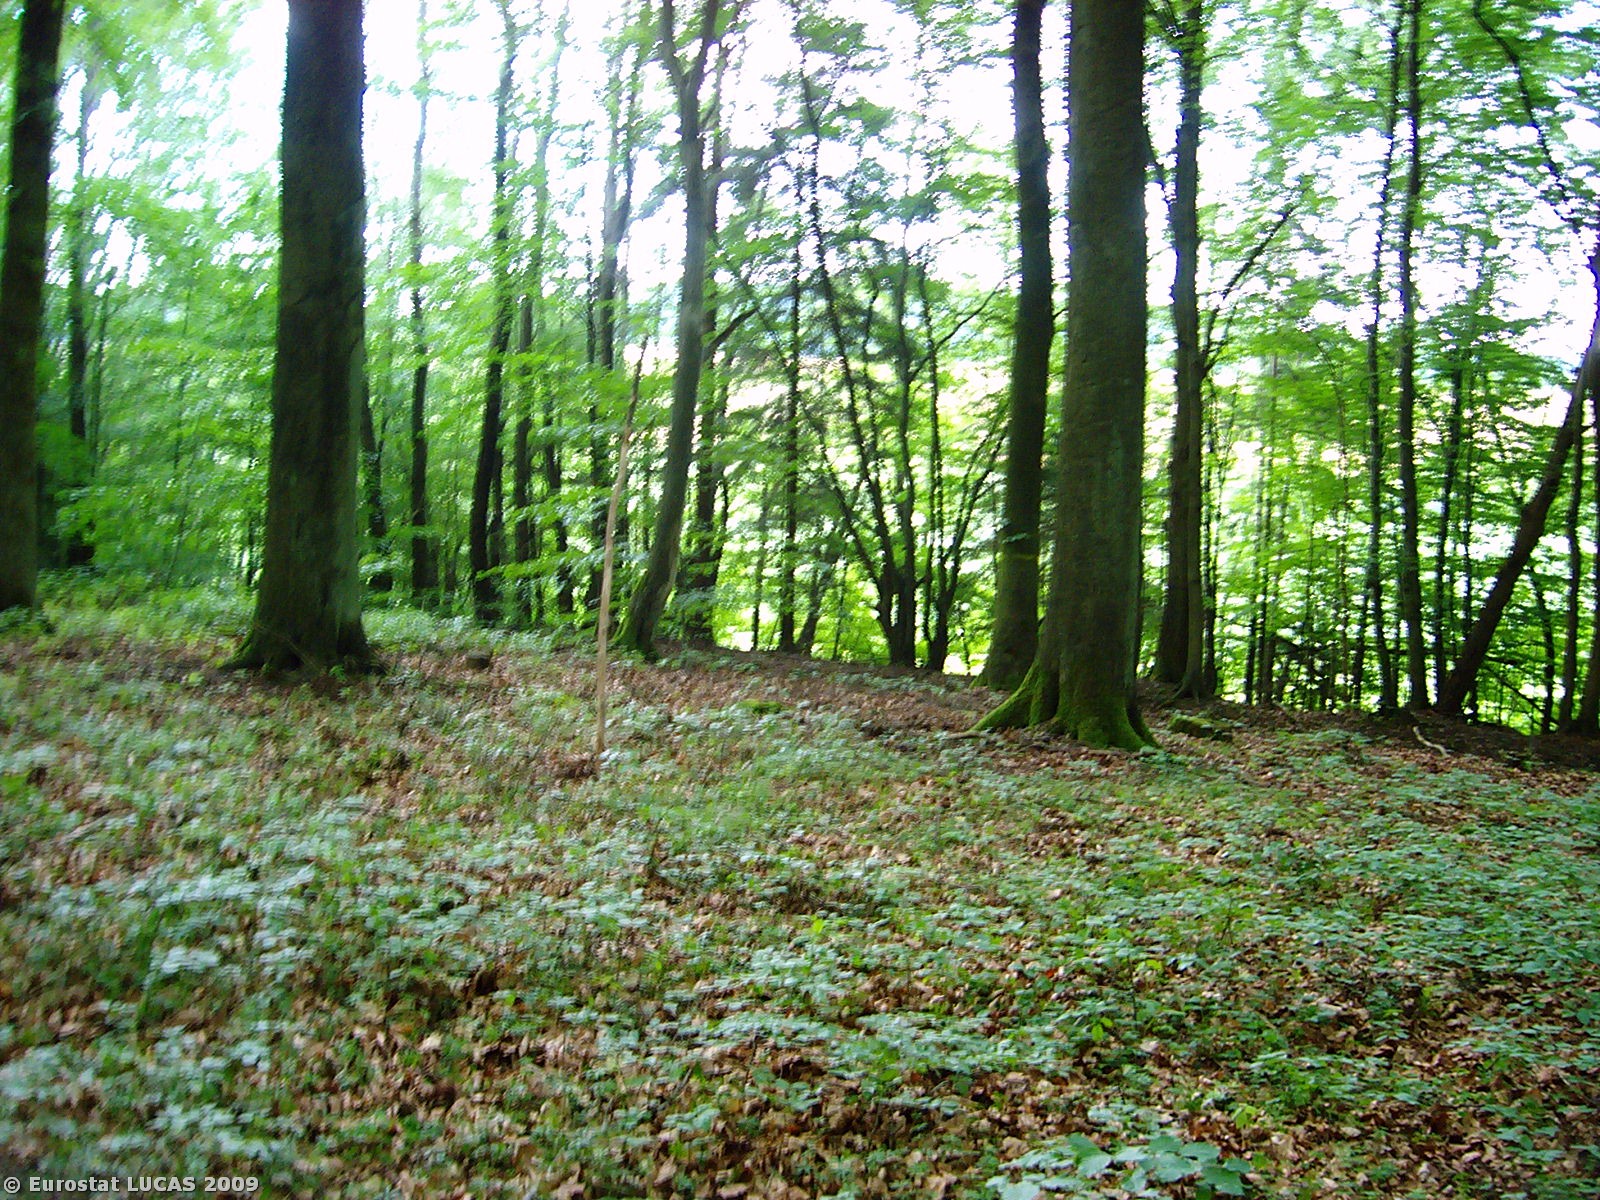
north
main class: Woodland
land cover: Broadleaved woodland
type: hemiboreal forest and nemoral coniferous forest and mixed broadleaved-coniferous forest
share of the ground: > 75 %
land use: Forestry
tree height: > 5 m
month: July
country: PL
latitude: 53.3497
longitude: 15.4865
